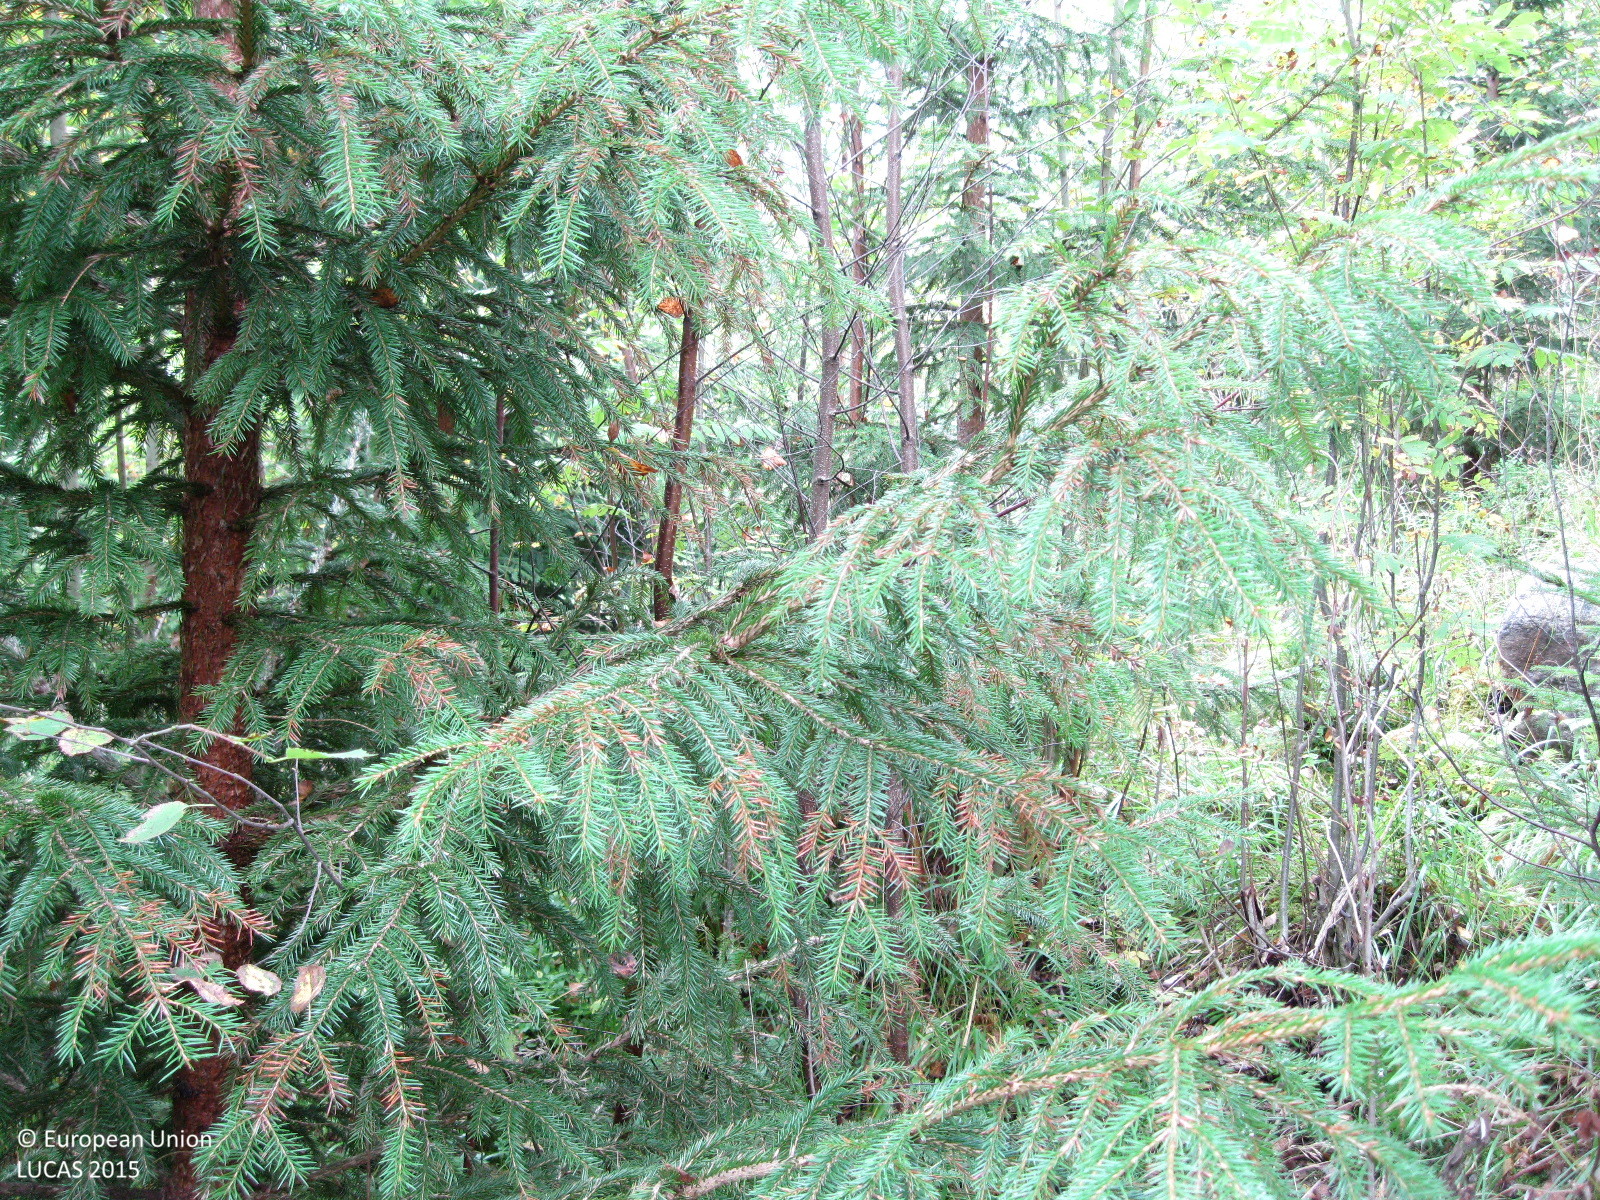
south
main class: Woodland
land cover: Broadleaved woodland
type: boreal forest
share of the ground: > 75 %
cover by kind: broadleaved forest trees 80 %, herbaceous plants 10 %, coniferous forest trees 5 %, shrubs 5 %
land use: Forestry
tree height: > 5 m
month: September
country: FI
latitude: 60.7973
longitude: 24.9040
